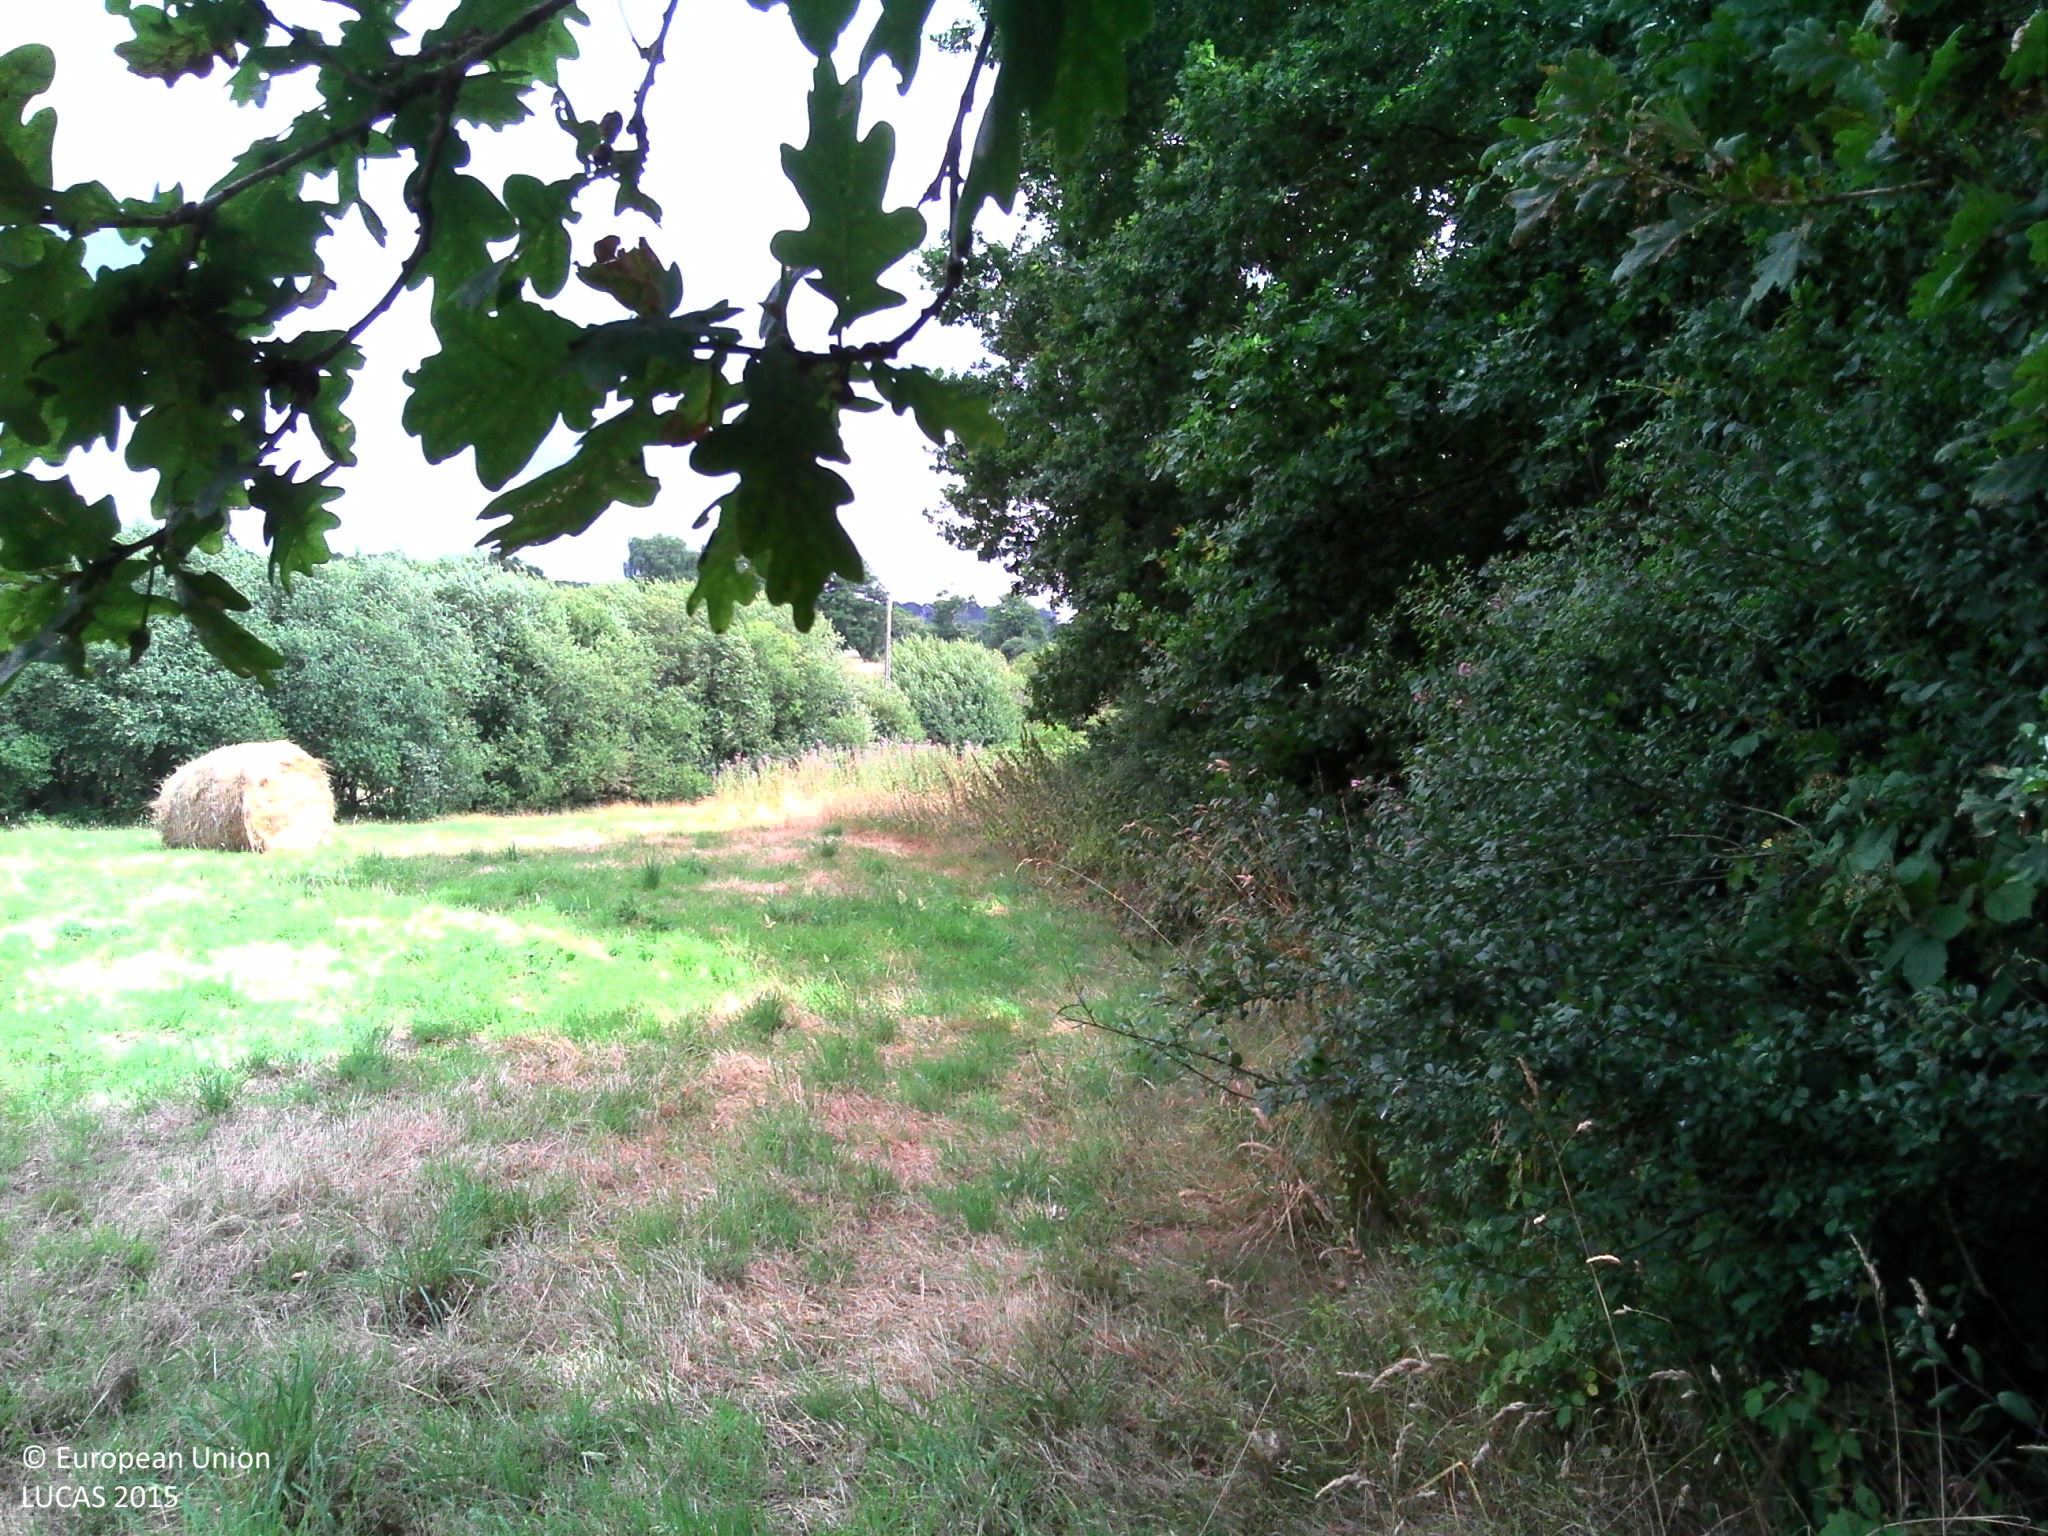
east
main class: Woodland
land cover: Broadleaved woodland
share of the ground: > 75 %
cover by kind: broadleaved forest trees 80 %, herbaceous plants 20 %
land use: Semi-natural and natural areas not in use
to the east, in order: Broadleaved woodland; Fences; Spontaneously vegetated surfaces; Grassland without tree/shrub cover; Lines of trees; Fences; Grassland without tree/shrub cover; Fences; Common wheat; Electric lines; Common wheat
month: July
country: FR
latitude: 48.3963
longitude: -0.0650
